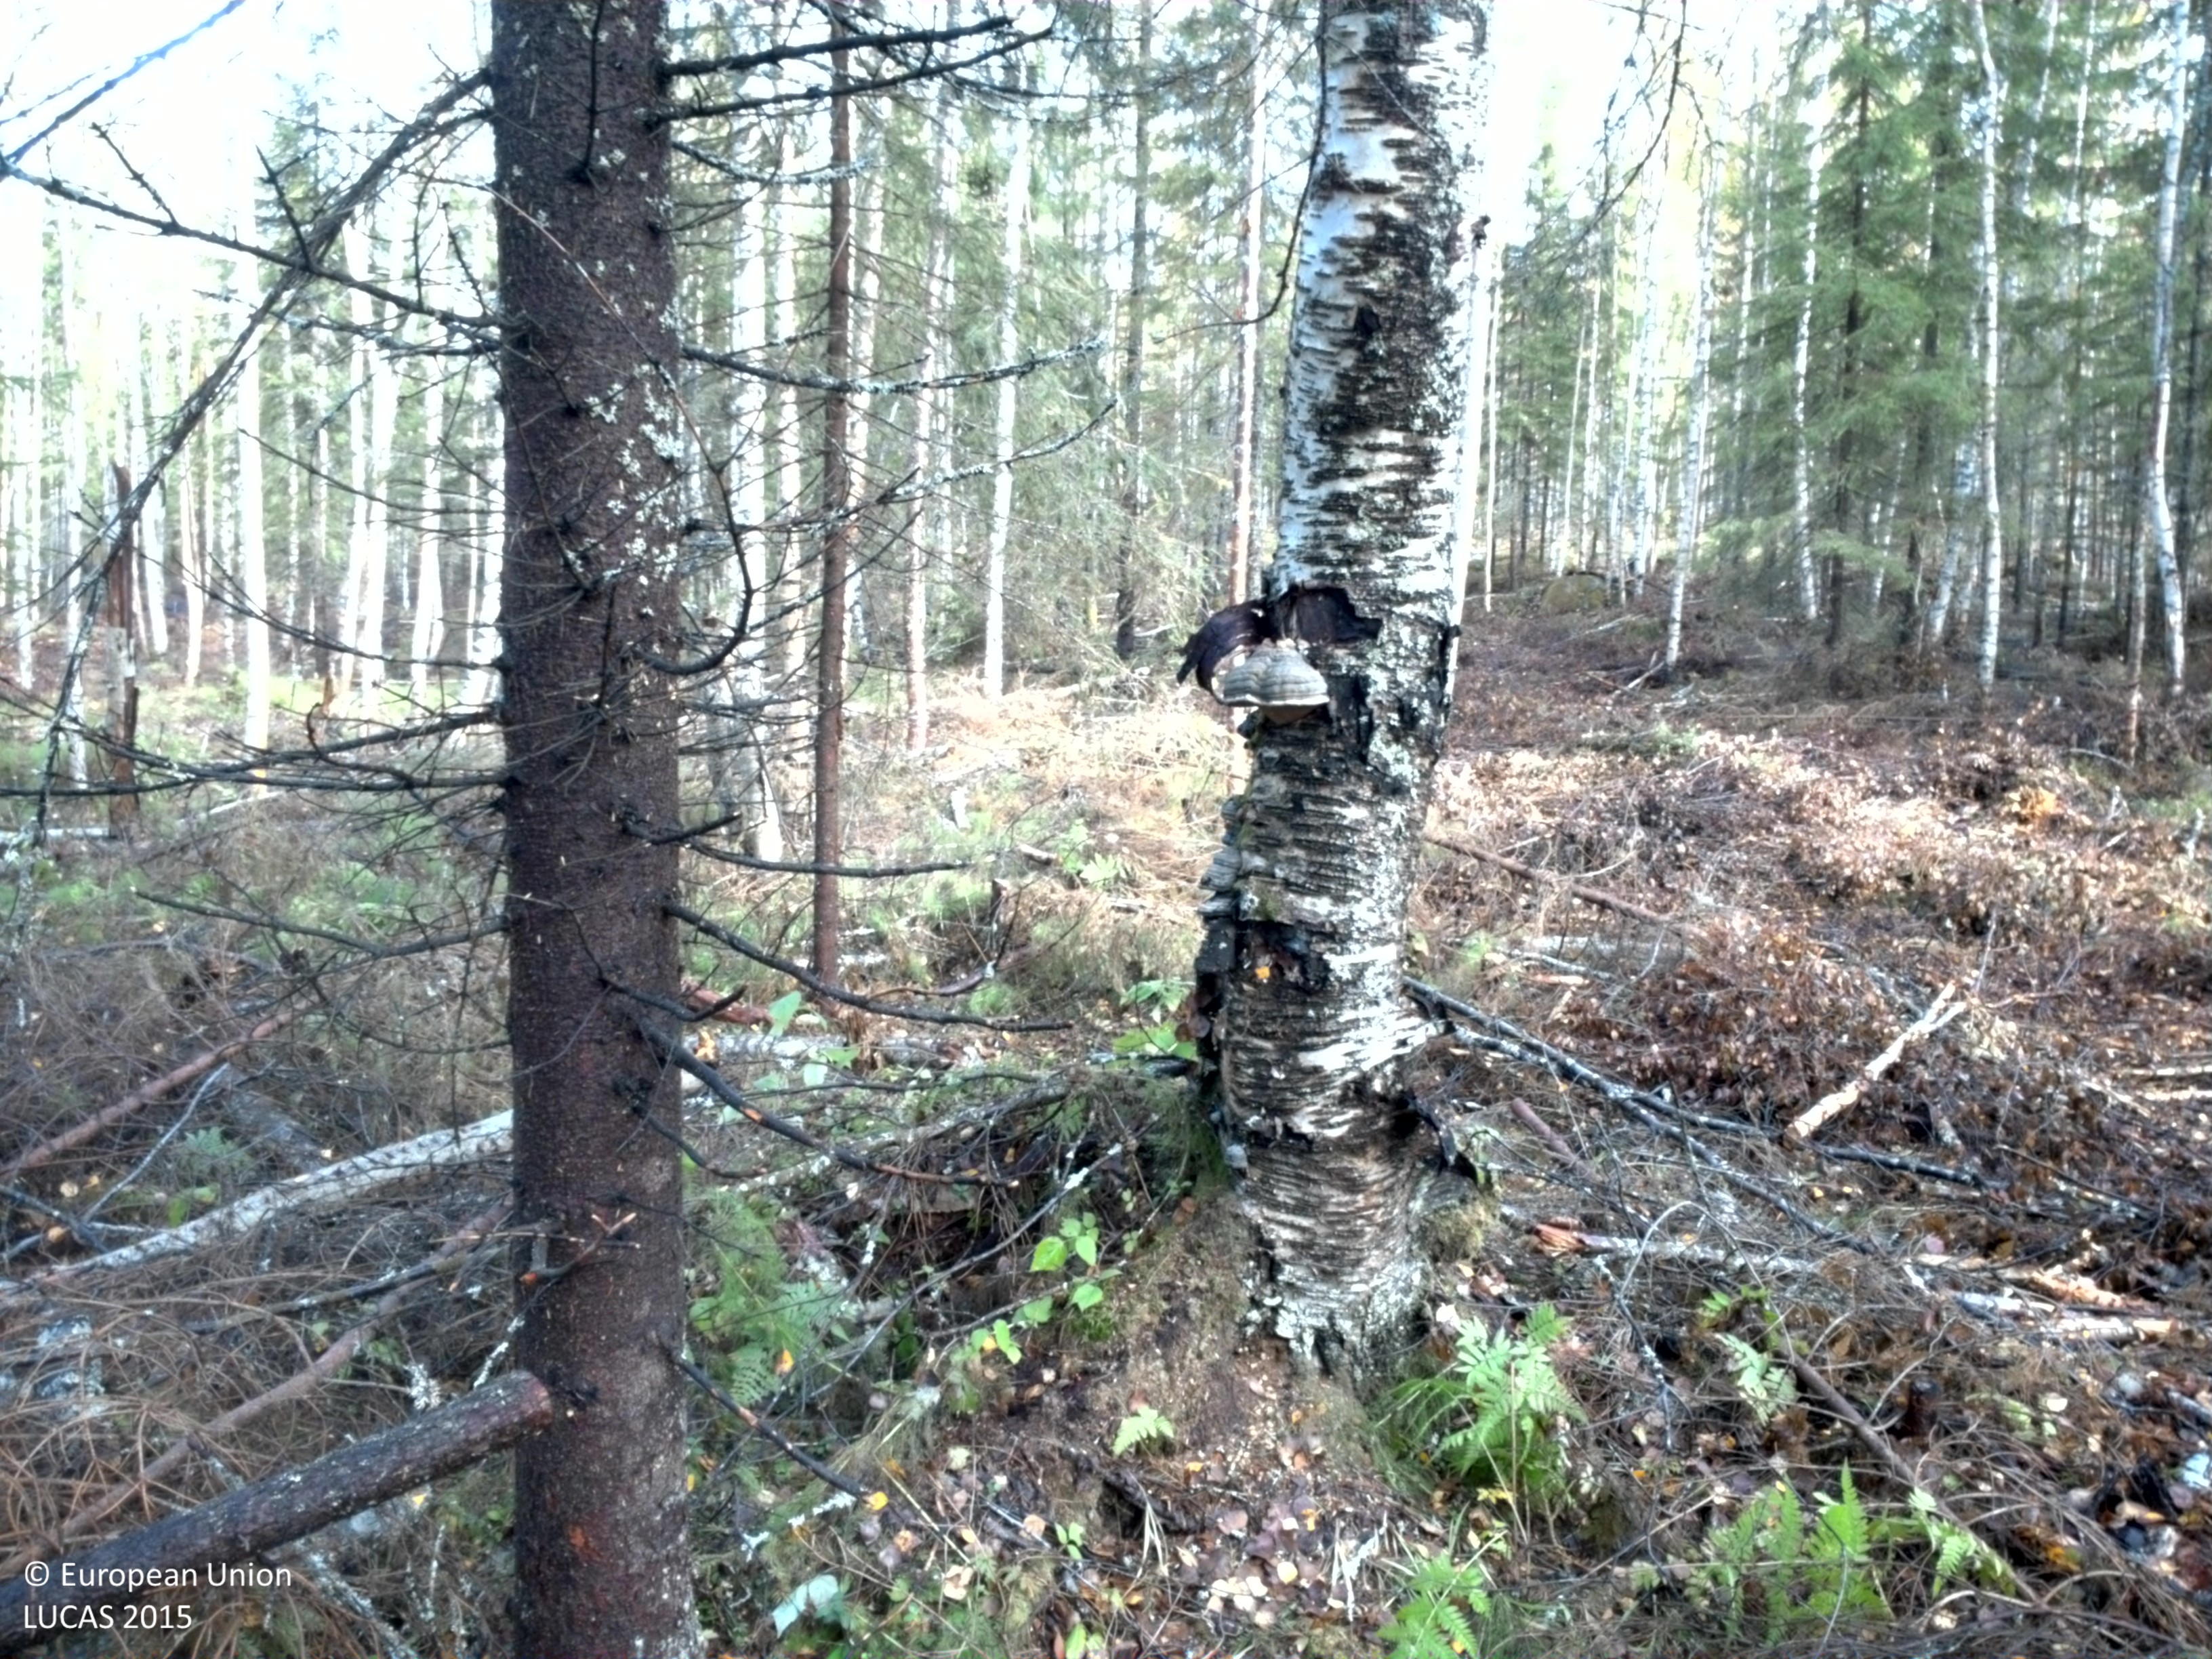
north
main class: Woodland
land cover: Broadleaved woodland
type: non-riverine alder, birch or aspen forest
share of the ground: 25 - 50 %
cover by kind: consolidated bare surface 35 %, broadleaved forest trees 30 %, lichens and mosses 15 %, shrubs 10 %, coniferous forest trees 5 %, herbaceous plants 5 %
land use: Forestry
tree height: > 5 m
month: September
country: SE
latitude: 65.7364
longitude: 22.2570
